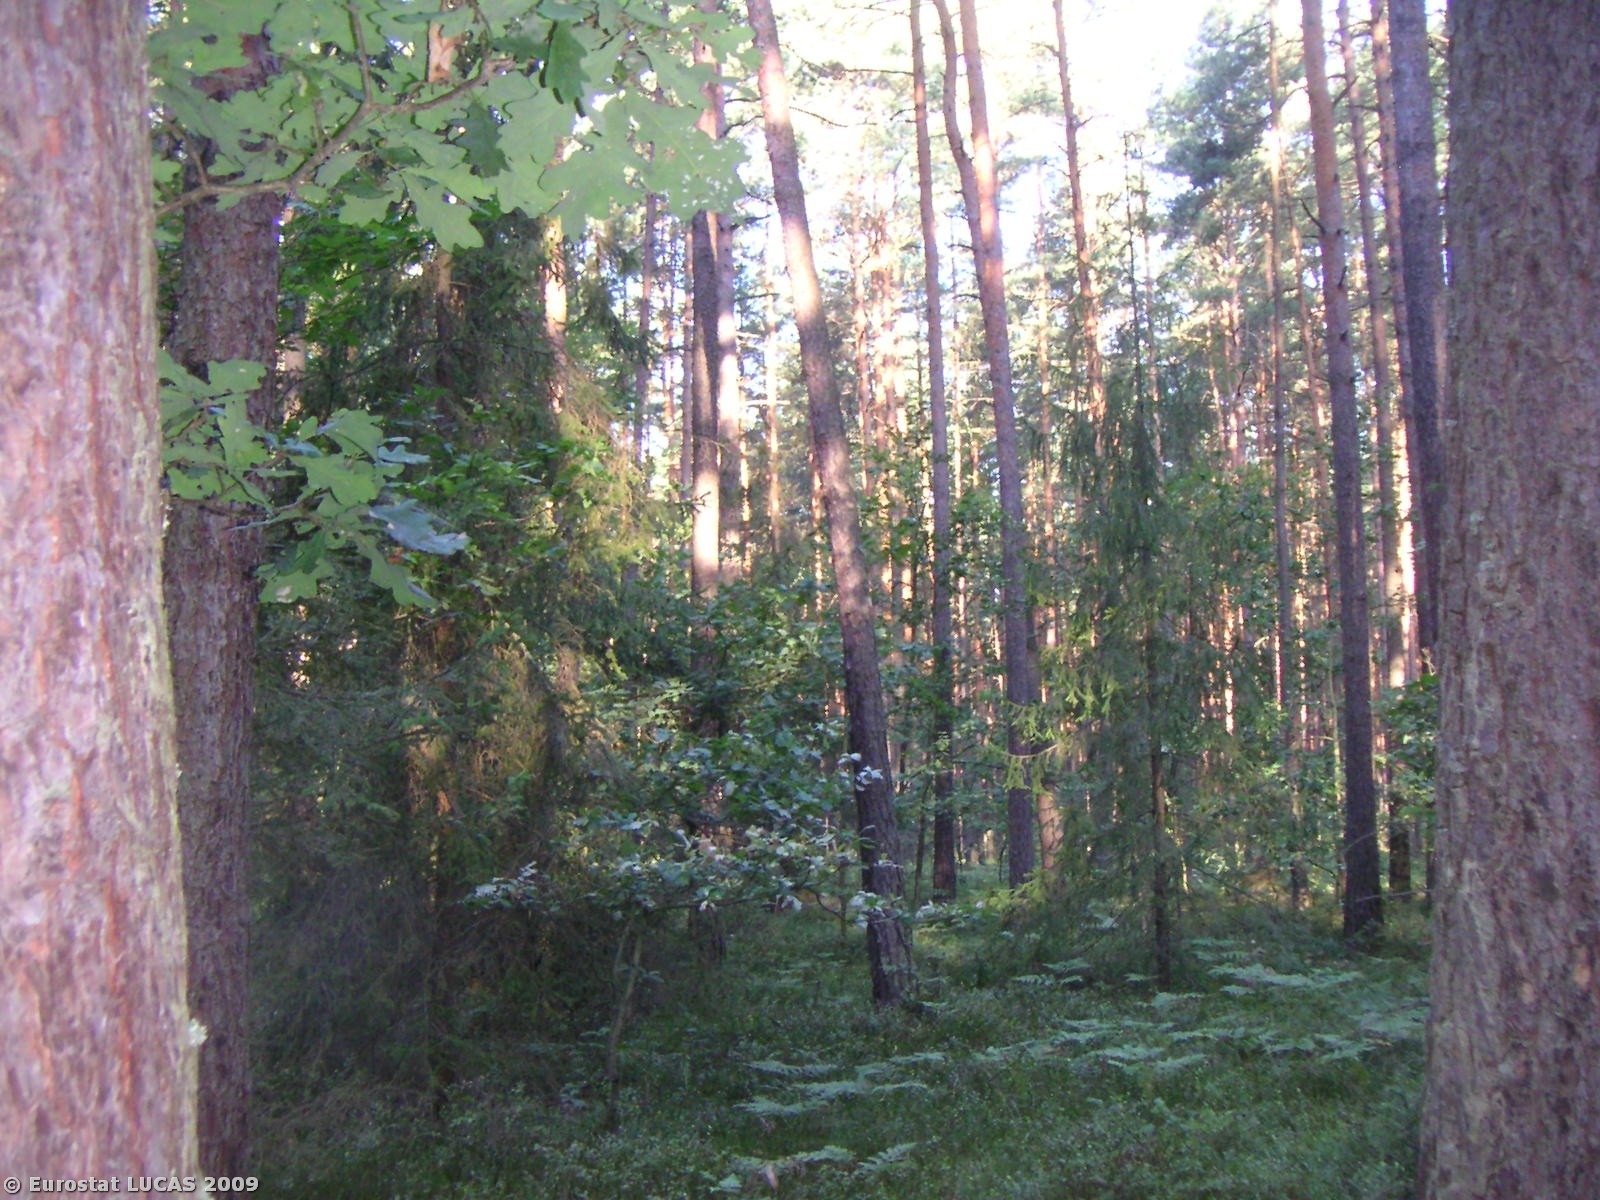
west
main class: Woodland
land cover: Coniferous woodland
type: hemiboreal forest and nemoral coniferous forest and mixed broadleaved-coniferous forest
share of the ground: > 75 %
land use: Forestry
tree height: > 5 m
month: August
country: PL
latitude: 50.6170
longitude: 18.8554
